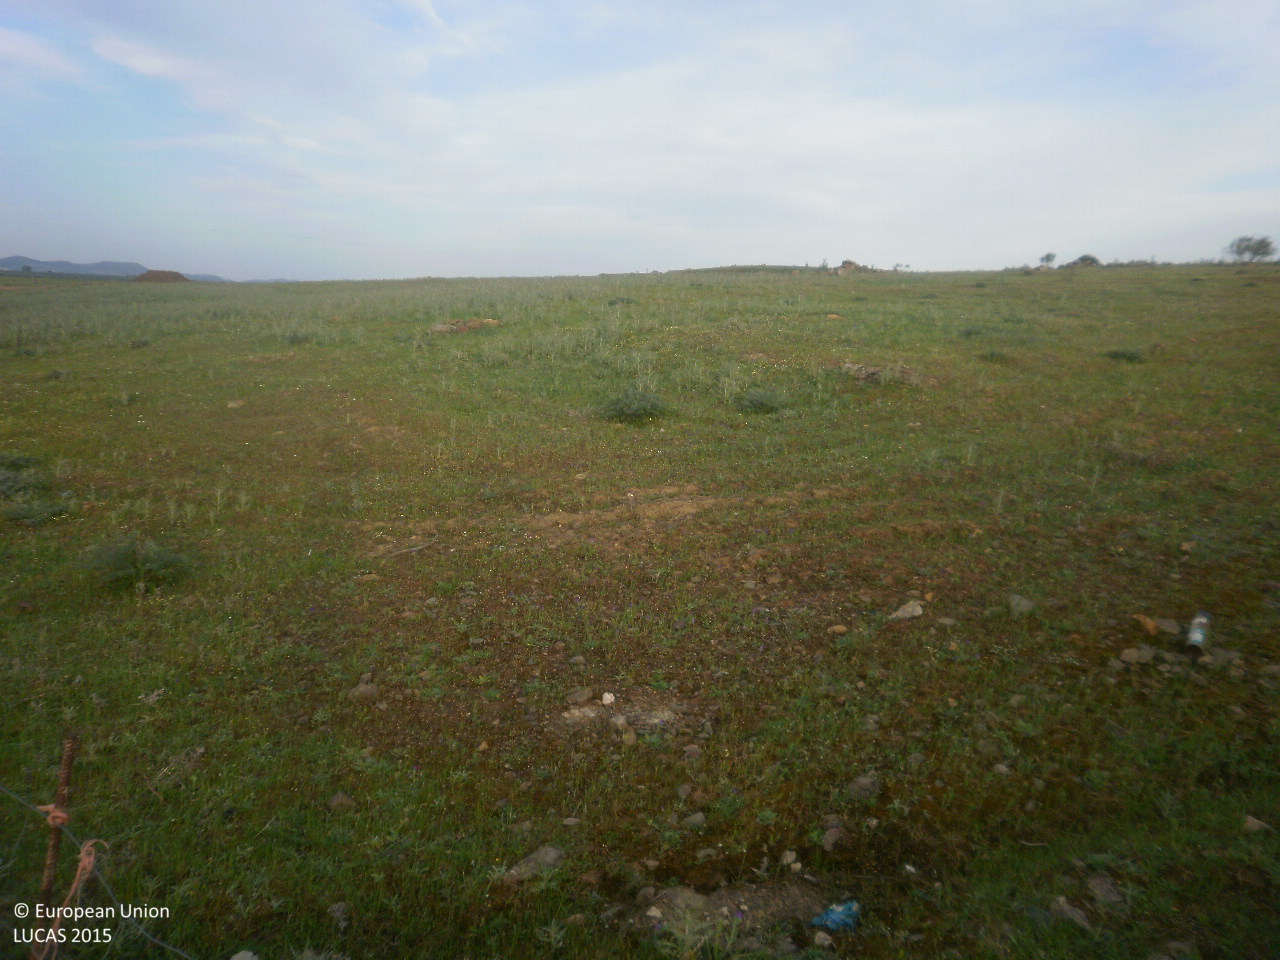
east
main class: Grassland
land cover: Grassland without tree/shrub cover
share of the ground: > 75 %
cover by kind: herbaceous plants 100 %
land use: Agriculture (excluding fallow land and kitchen gardens)
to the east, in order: Grassland without tree/shrub cover; Fences; Ditches and canals; Tracks; Grassland without tree/shrub cover; Tracks; Grassland without tree/shrub cover; Fences; Grassland without tree/shrub cover
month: April
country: ES
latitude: 39.0831
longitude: -5.2660
